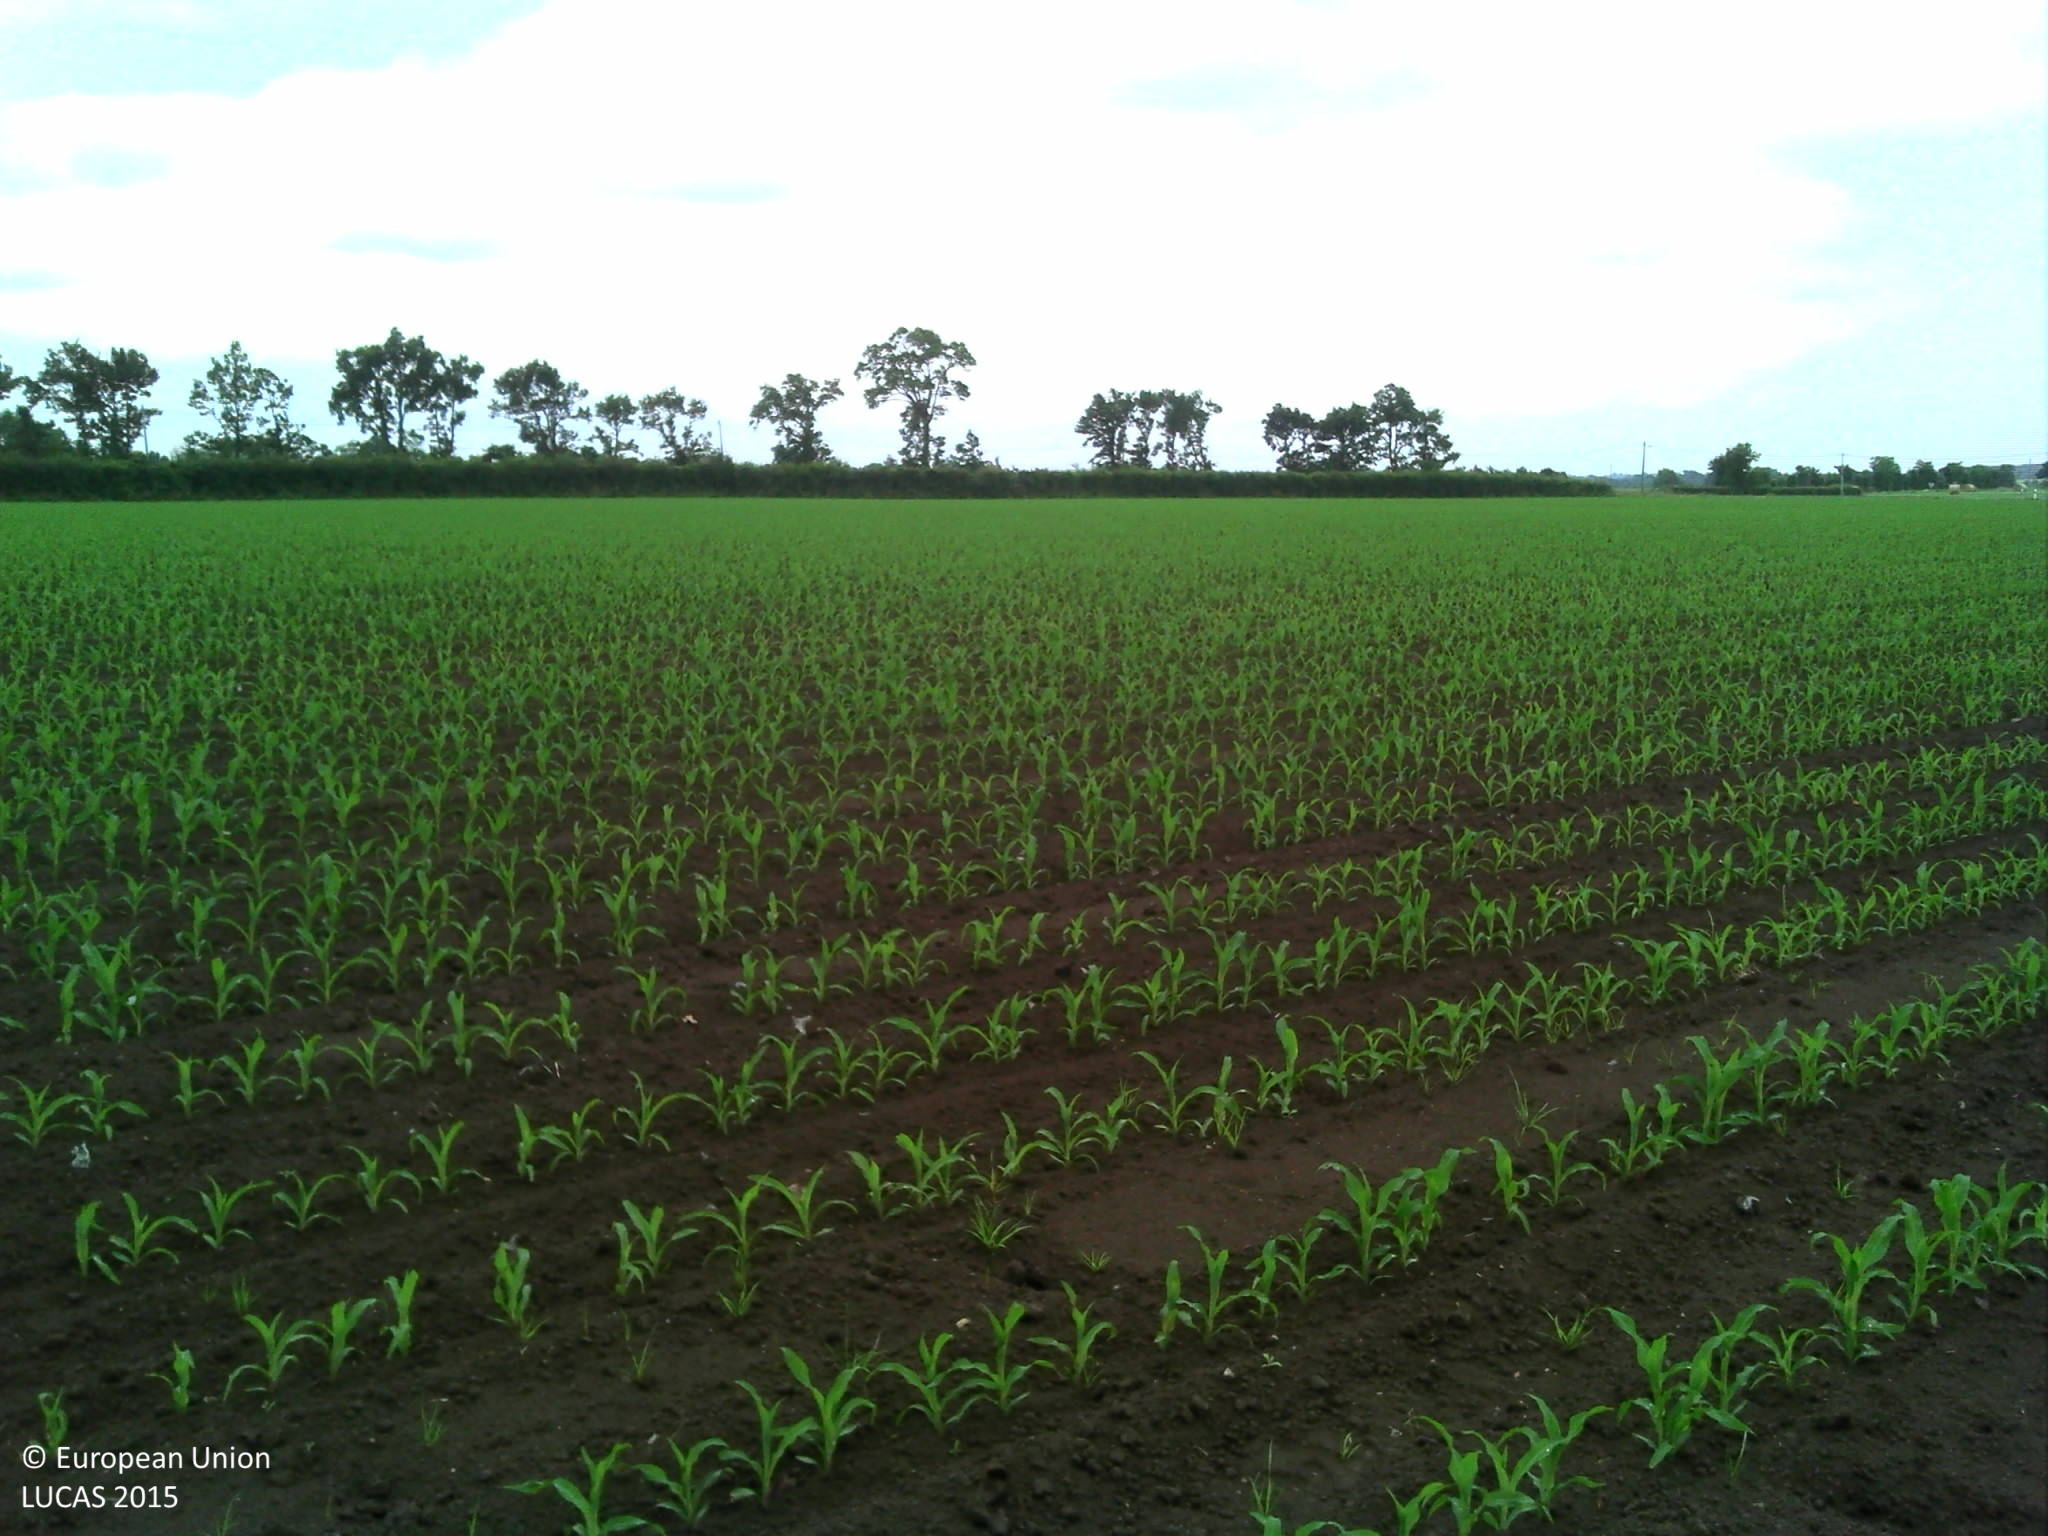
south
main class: Cropland
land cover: Maize
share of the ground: 10 - 25 %
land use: Agriculture (excluding fallow land and kitchen gardens)
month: June
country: FR
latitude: 46.8954
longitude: -1.4719
